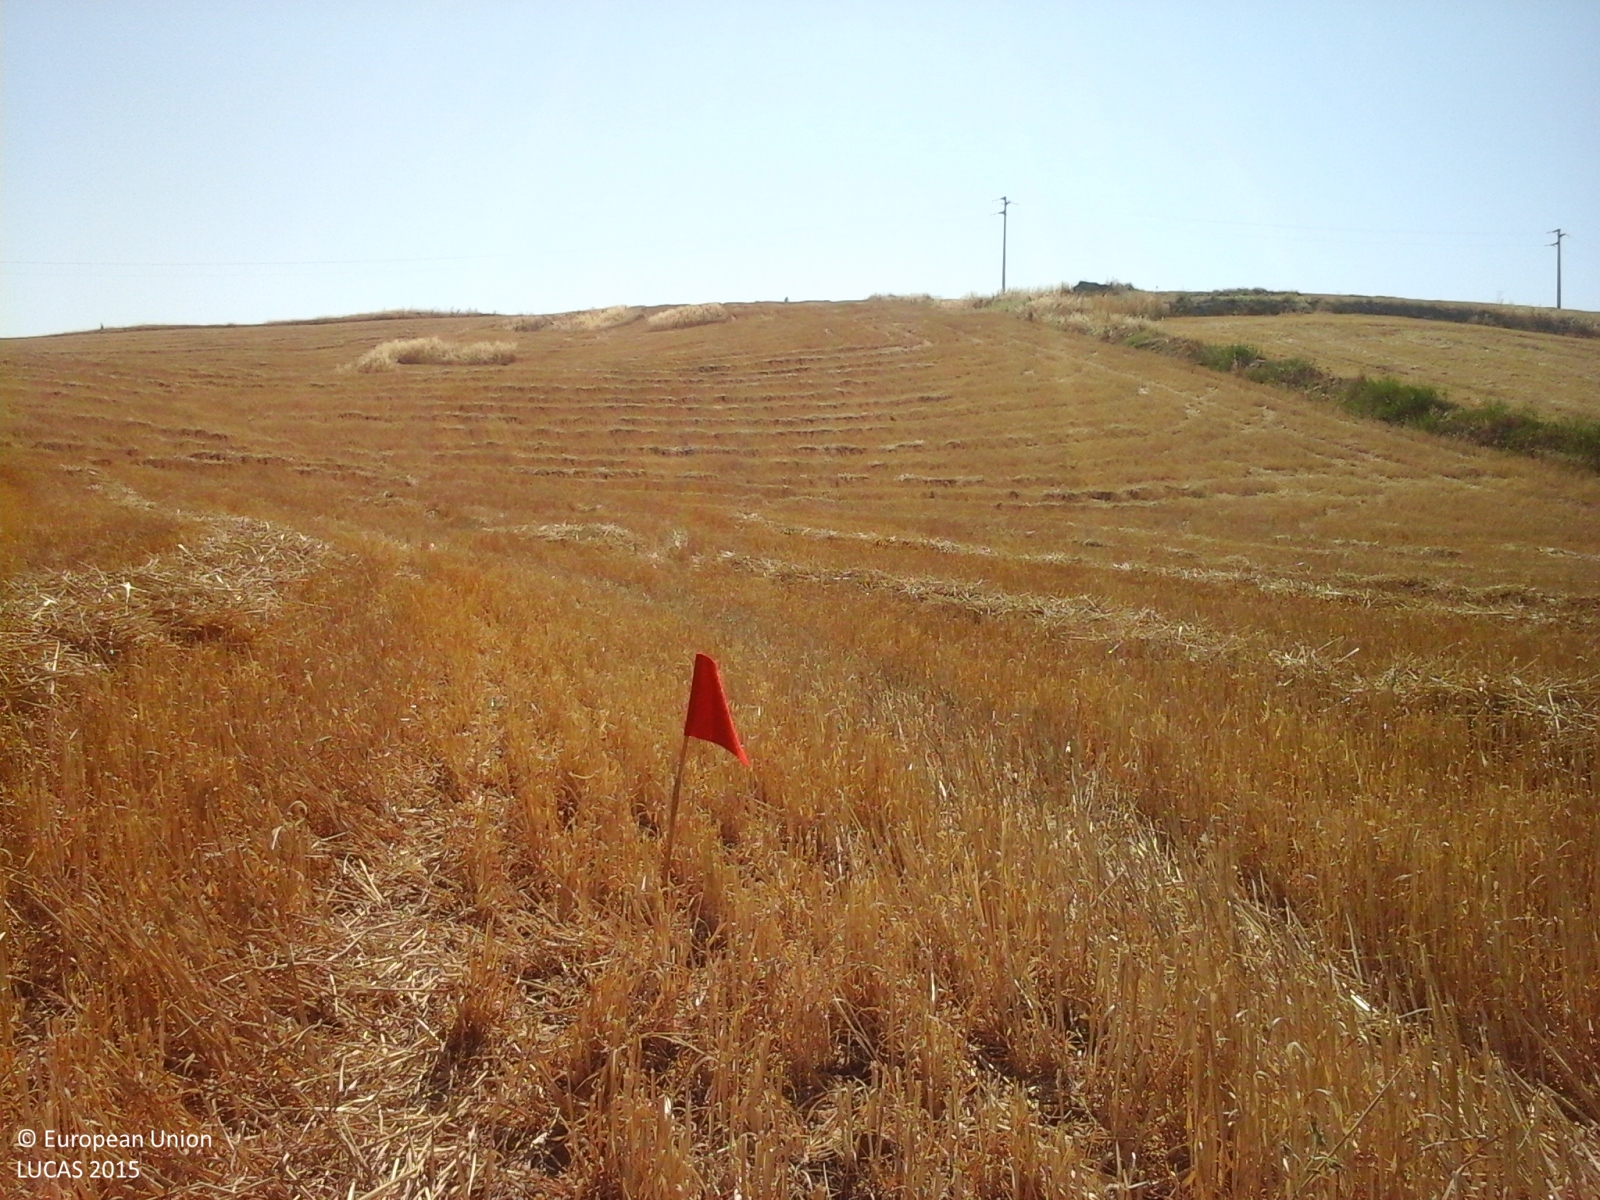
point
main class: Cropland
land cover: Durum wheat
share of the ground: > 75 %
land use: Agriculture (excluding fallow land and kitchen gardens)
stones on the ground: < 10 %
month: July
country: IT
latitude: 37.3541
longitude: 13.5512
